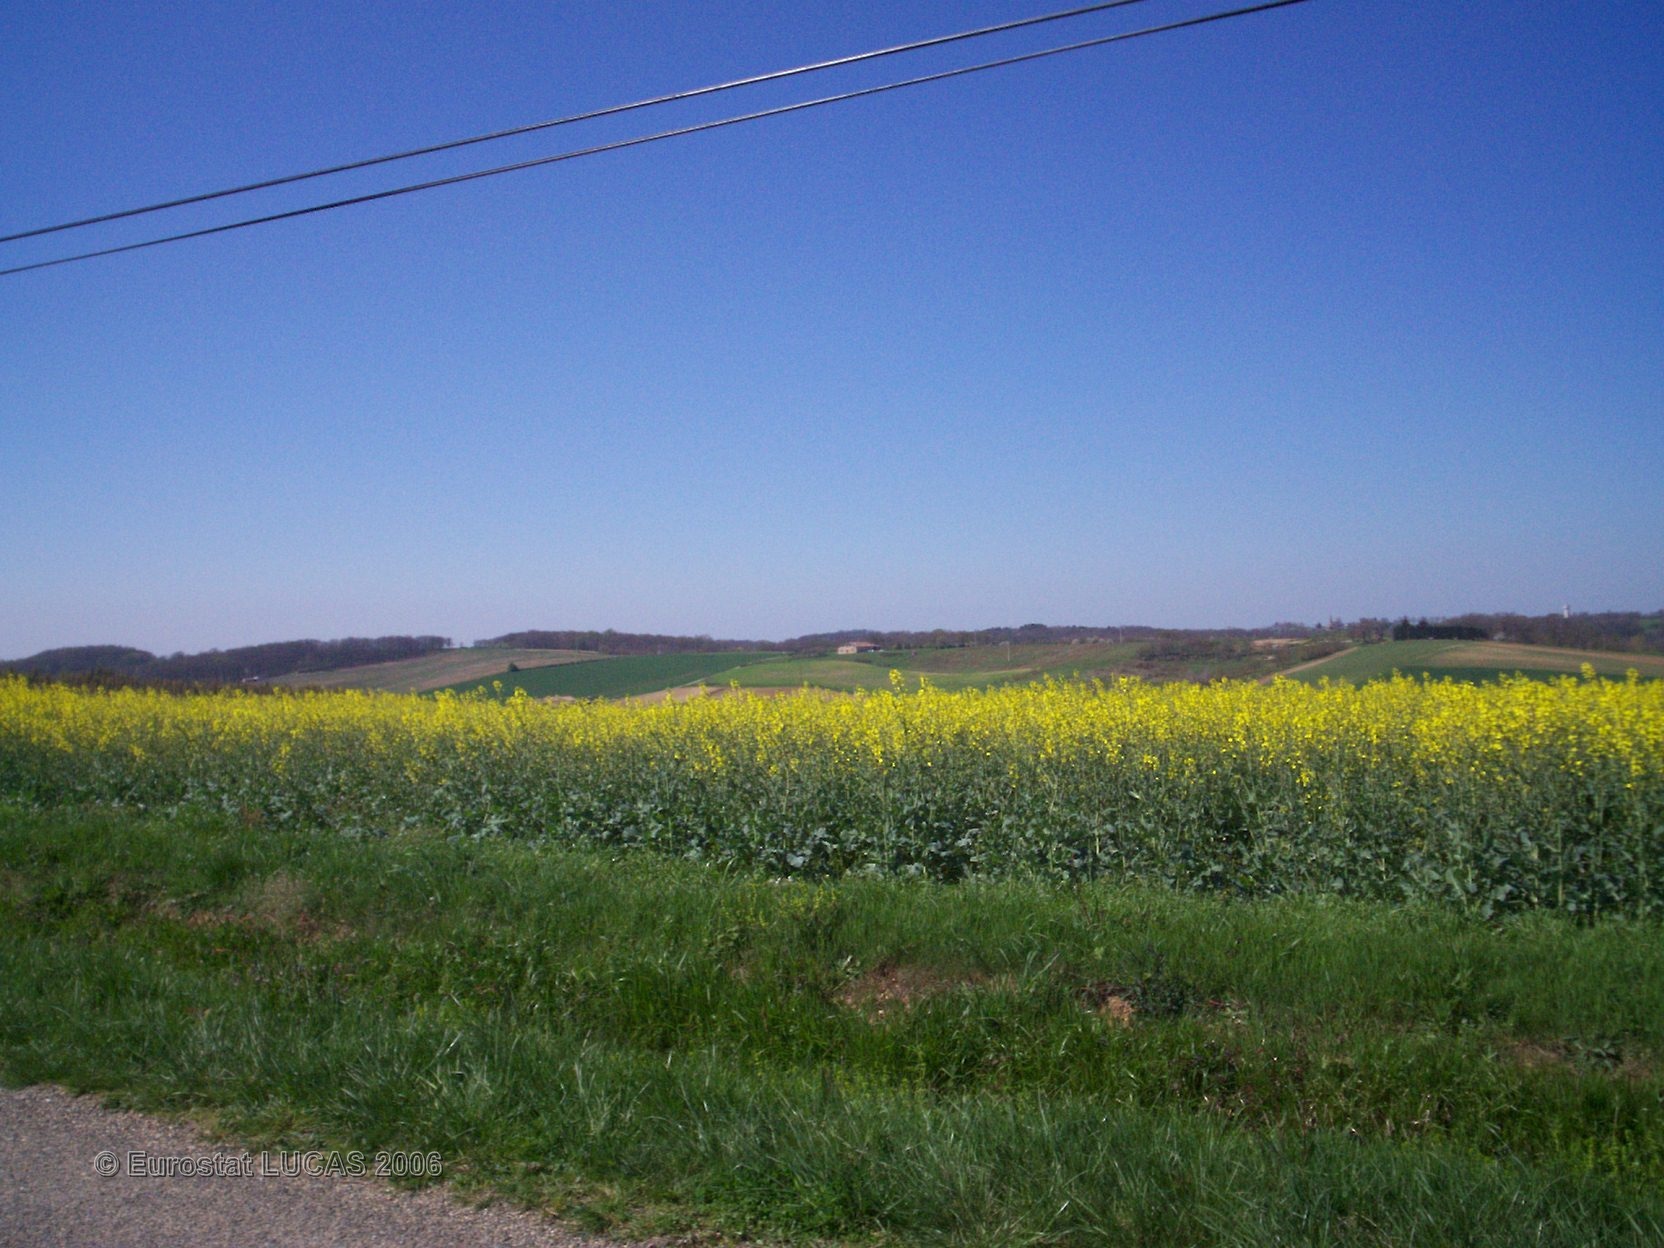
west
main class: Grassland
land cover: Grassland without tree/shrub cover
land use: Agriculture (excluding fallow land and kitchen gardens)
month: April
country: FR
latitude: 43.9334
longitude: 0.9169
